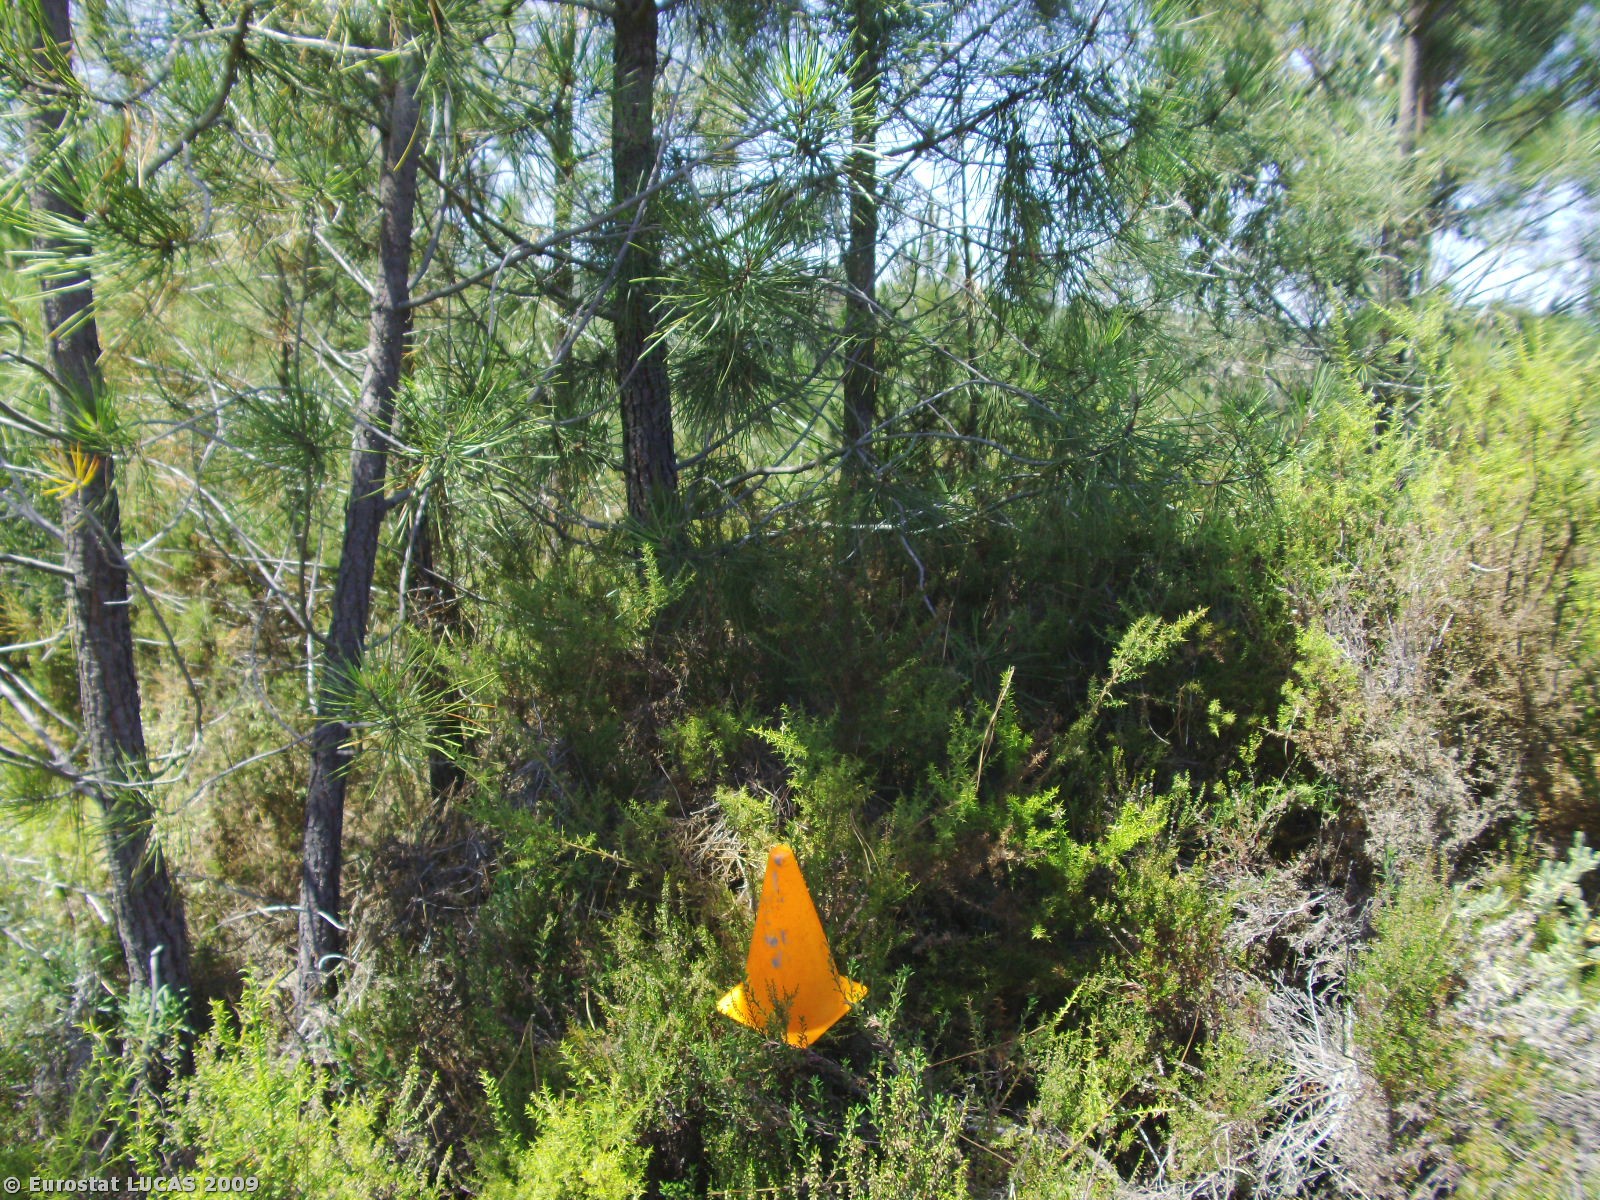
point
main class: Shrubland
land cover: Shrubland with sparse tree cover
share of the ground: > 75 %
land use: Unused
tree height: > 5 m
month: July
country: PT
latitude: 38.6027
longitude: -9.1457
